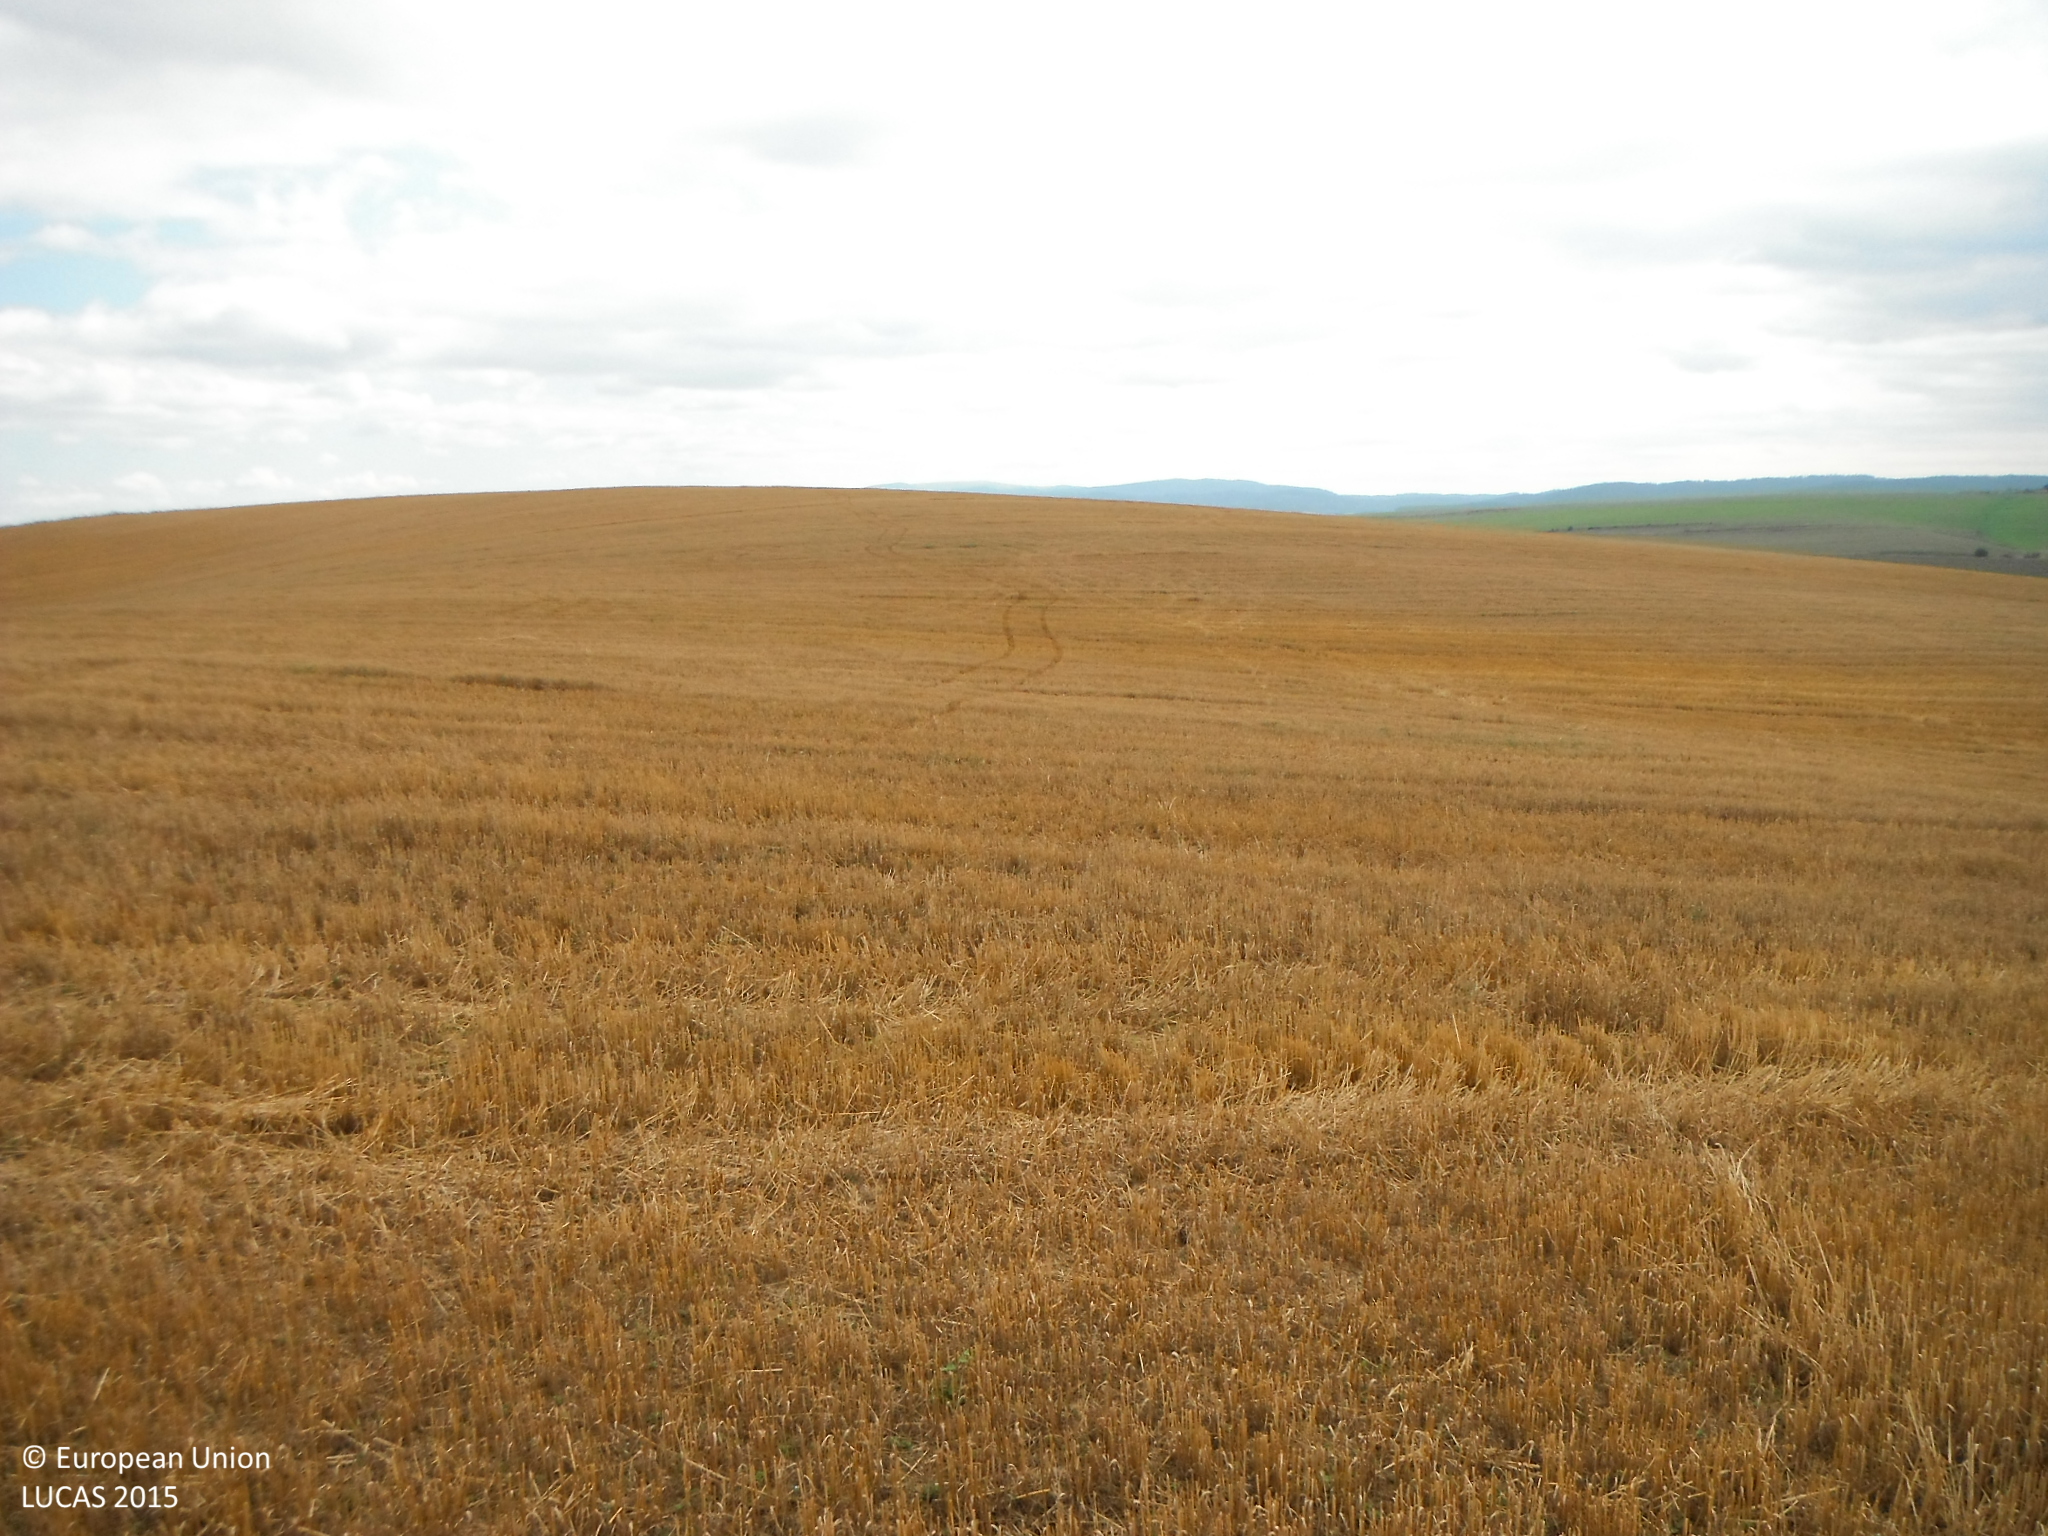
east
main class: Cropland
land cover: Barley
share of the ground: > 75 %
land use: Agriculture (excluding fallow land and kitchen gardens)
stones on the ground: 25 - 50 %
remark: Harvested field
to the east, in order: Barley
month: August
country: SK
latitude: 49.0753
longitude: 20.3704
